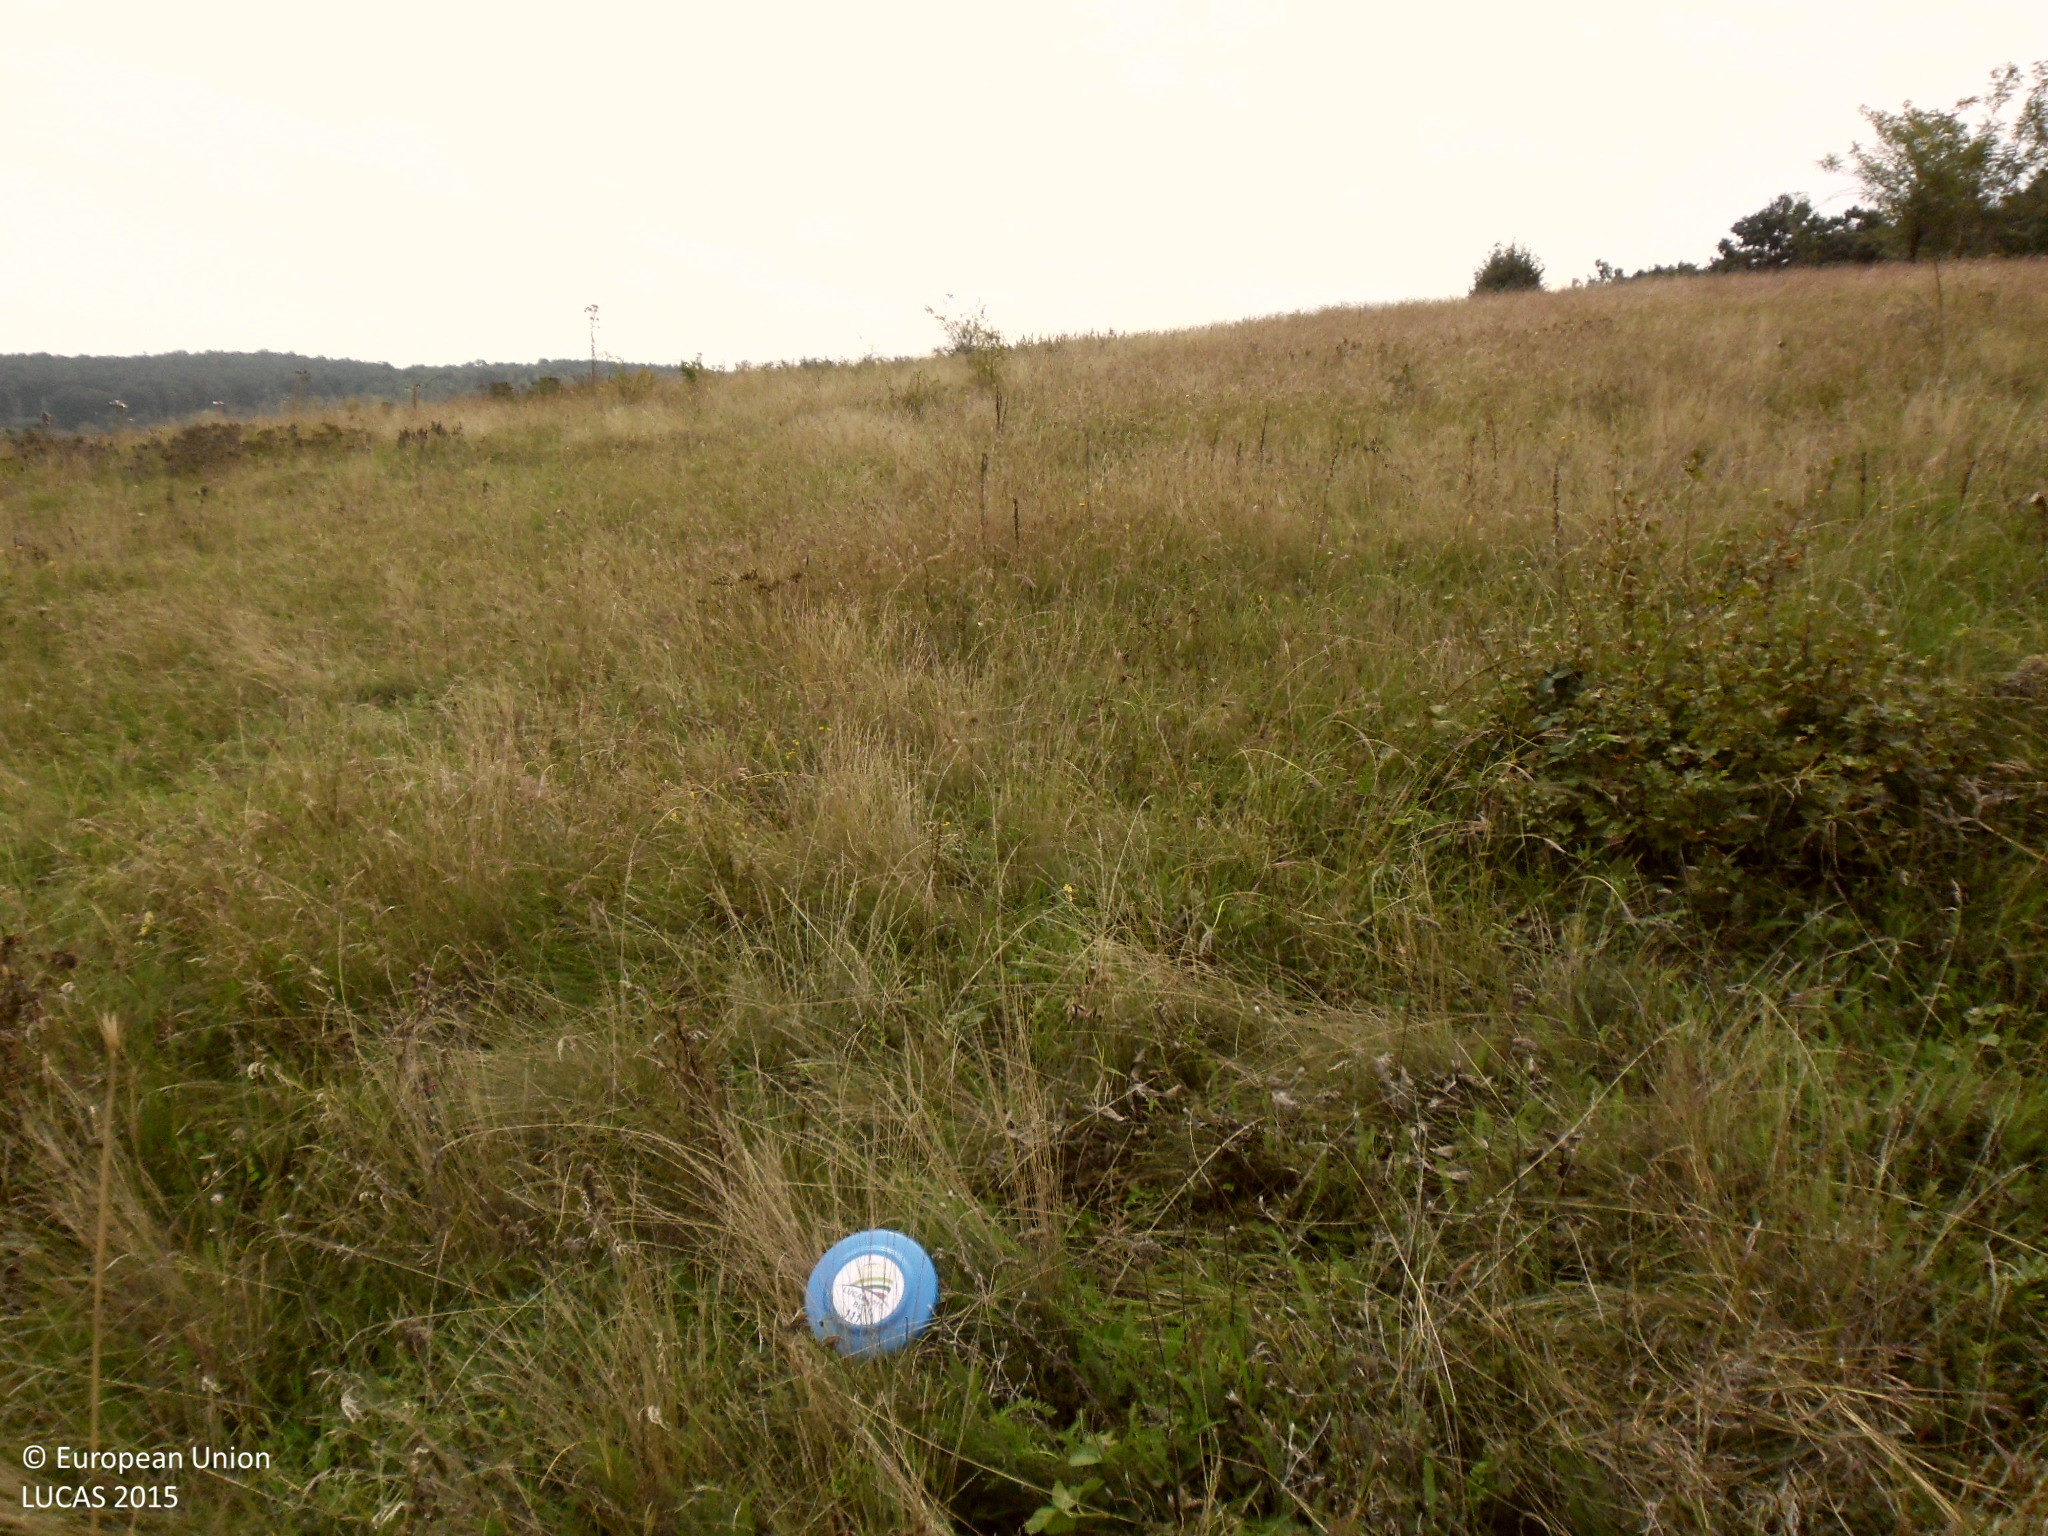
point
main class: Grassland
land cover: Grassland without tree/shrub cover
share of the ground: > 75 %
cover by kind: herbaceous plants 95 %, shrubs 5 %
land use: Agriculture (excluding fallow land and kitchen gardens)
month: October
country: BG
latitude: 44.0110
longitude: 22.6469
